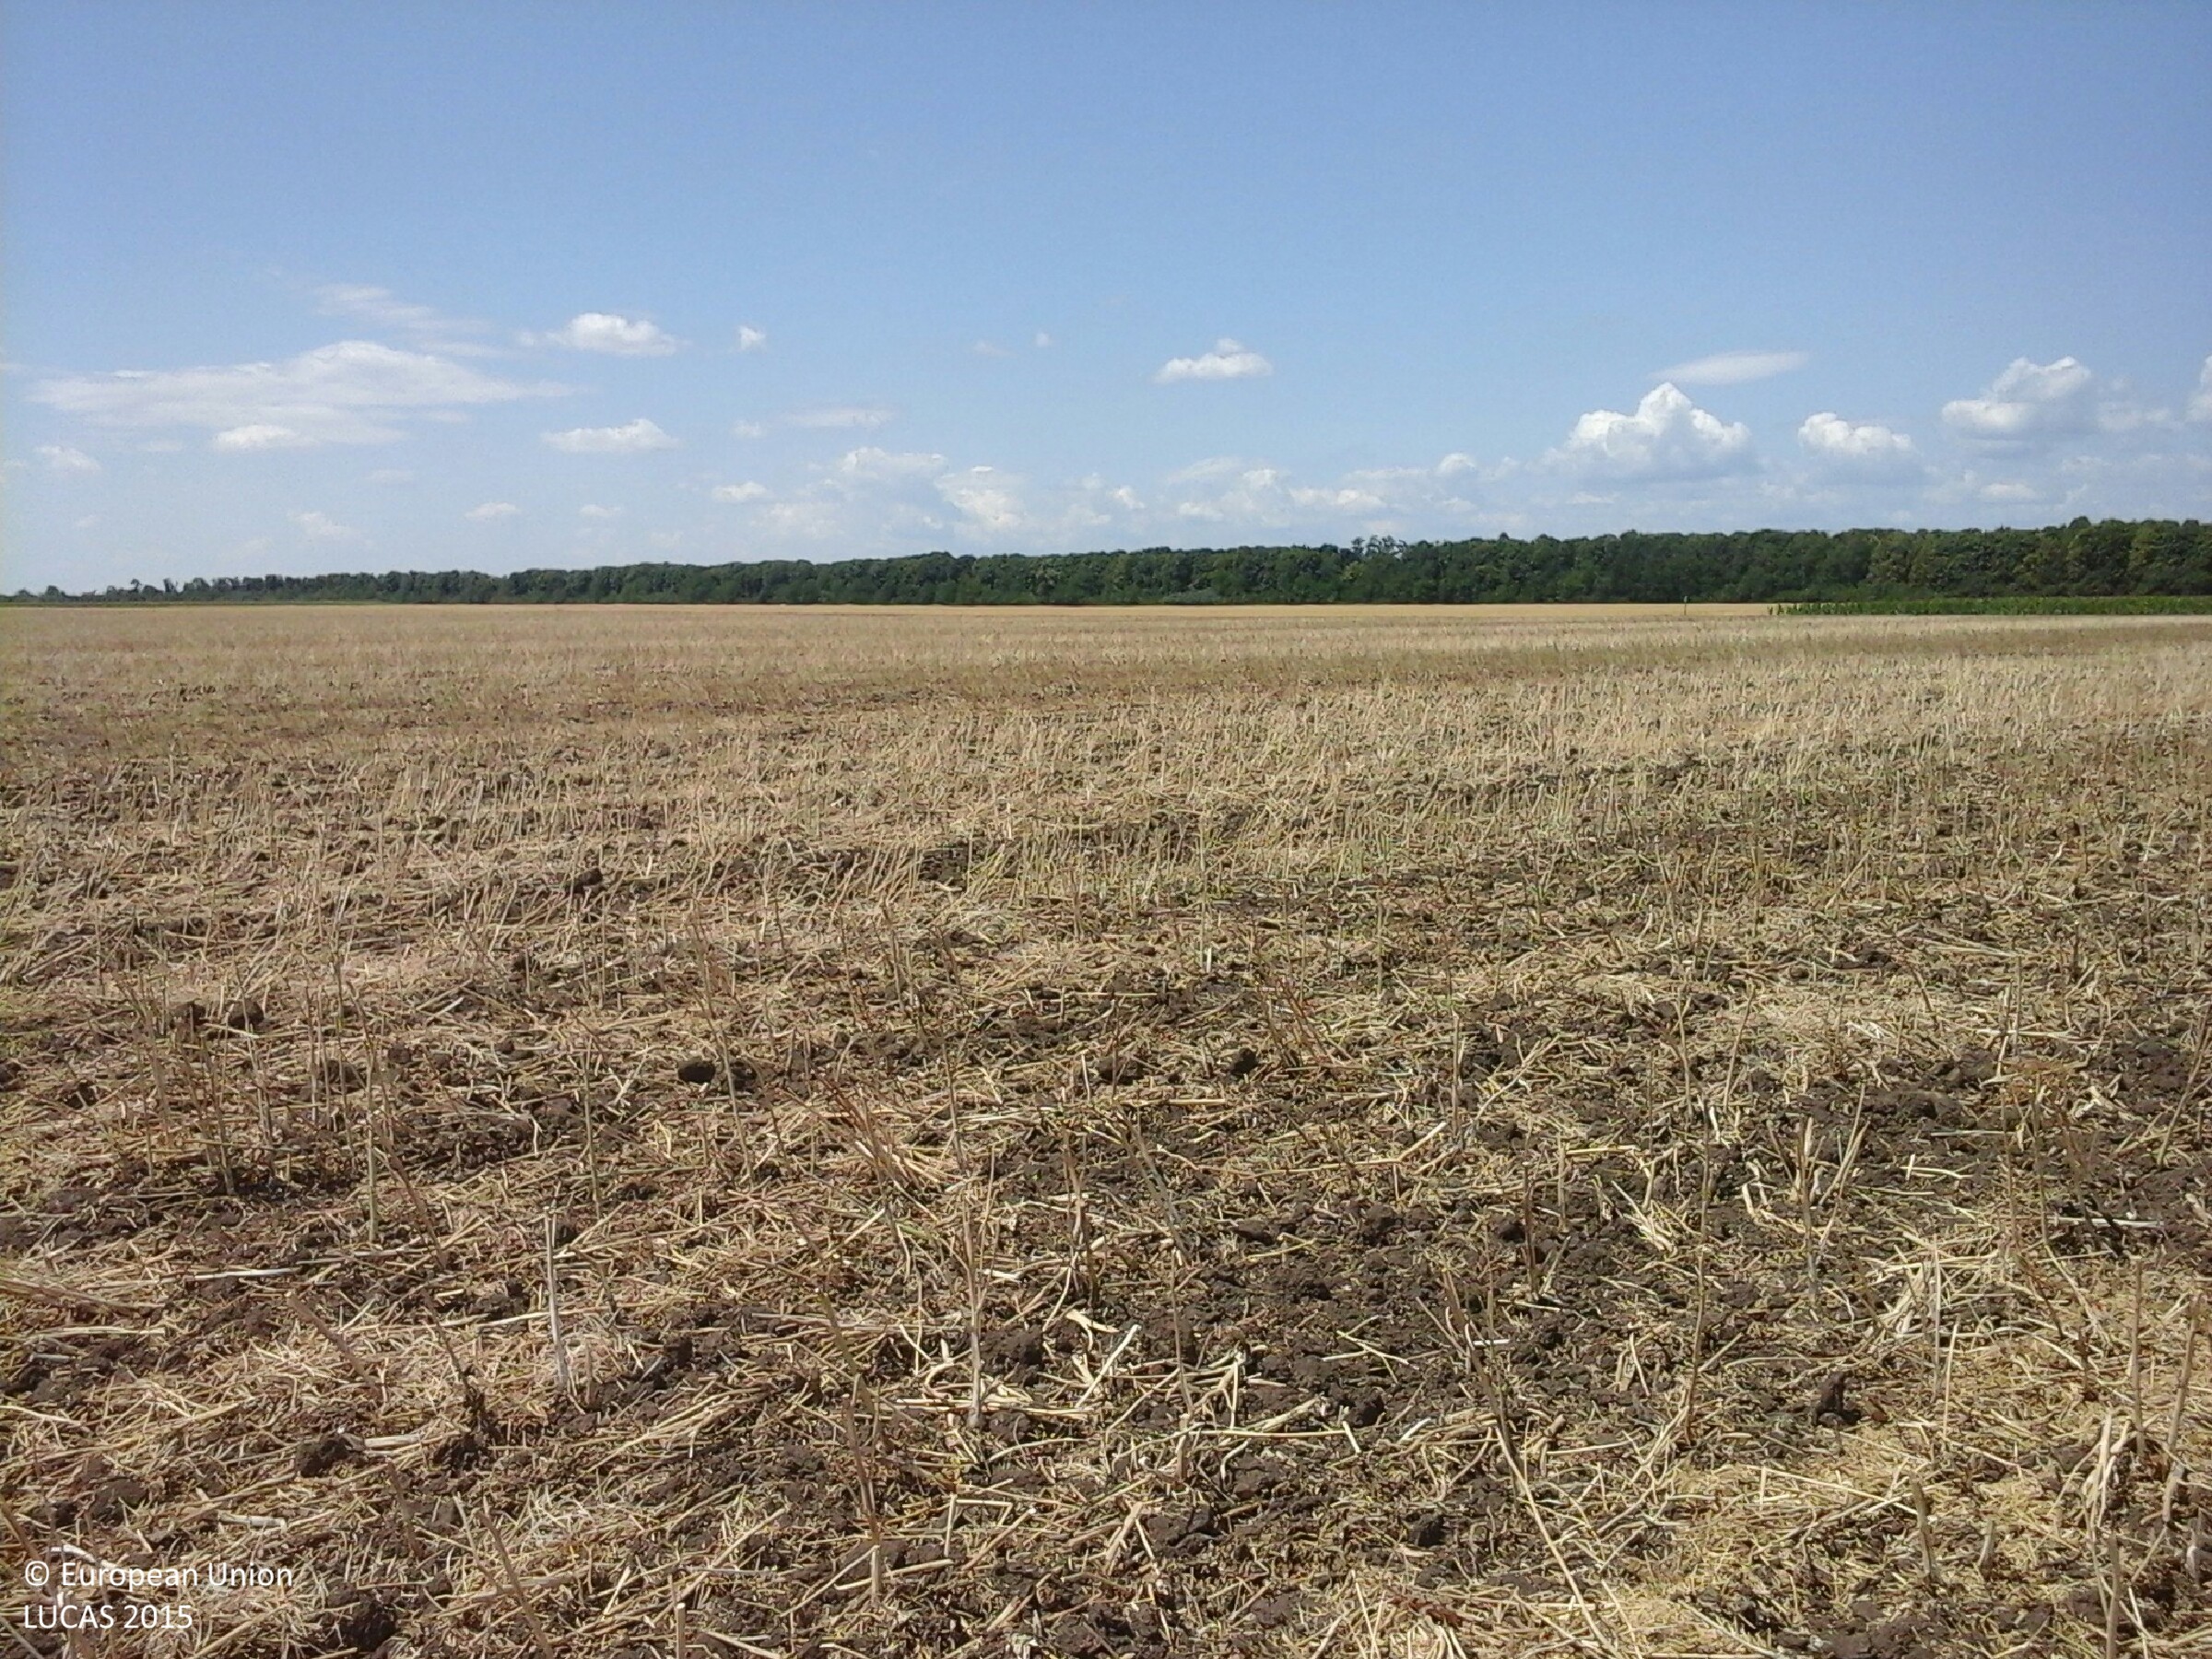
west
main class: Cropland
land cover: Rape and turnip rape
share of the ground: 25 - 50 %
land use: Agriculture (excluding fallow land and kitchen gardens)
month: July
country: HU
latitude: 47.8175
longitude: 20.6248
